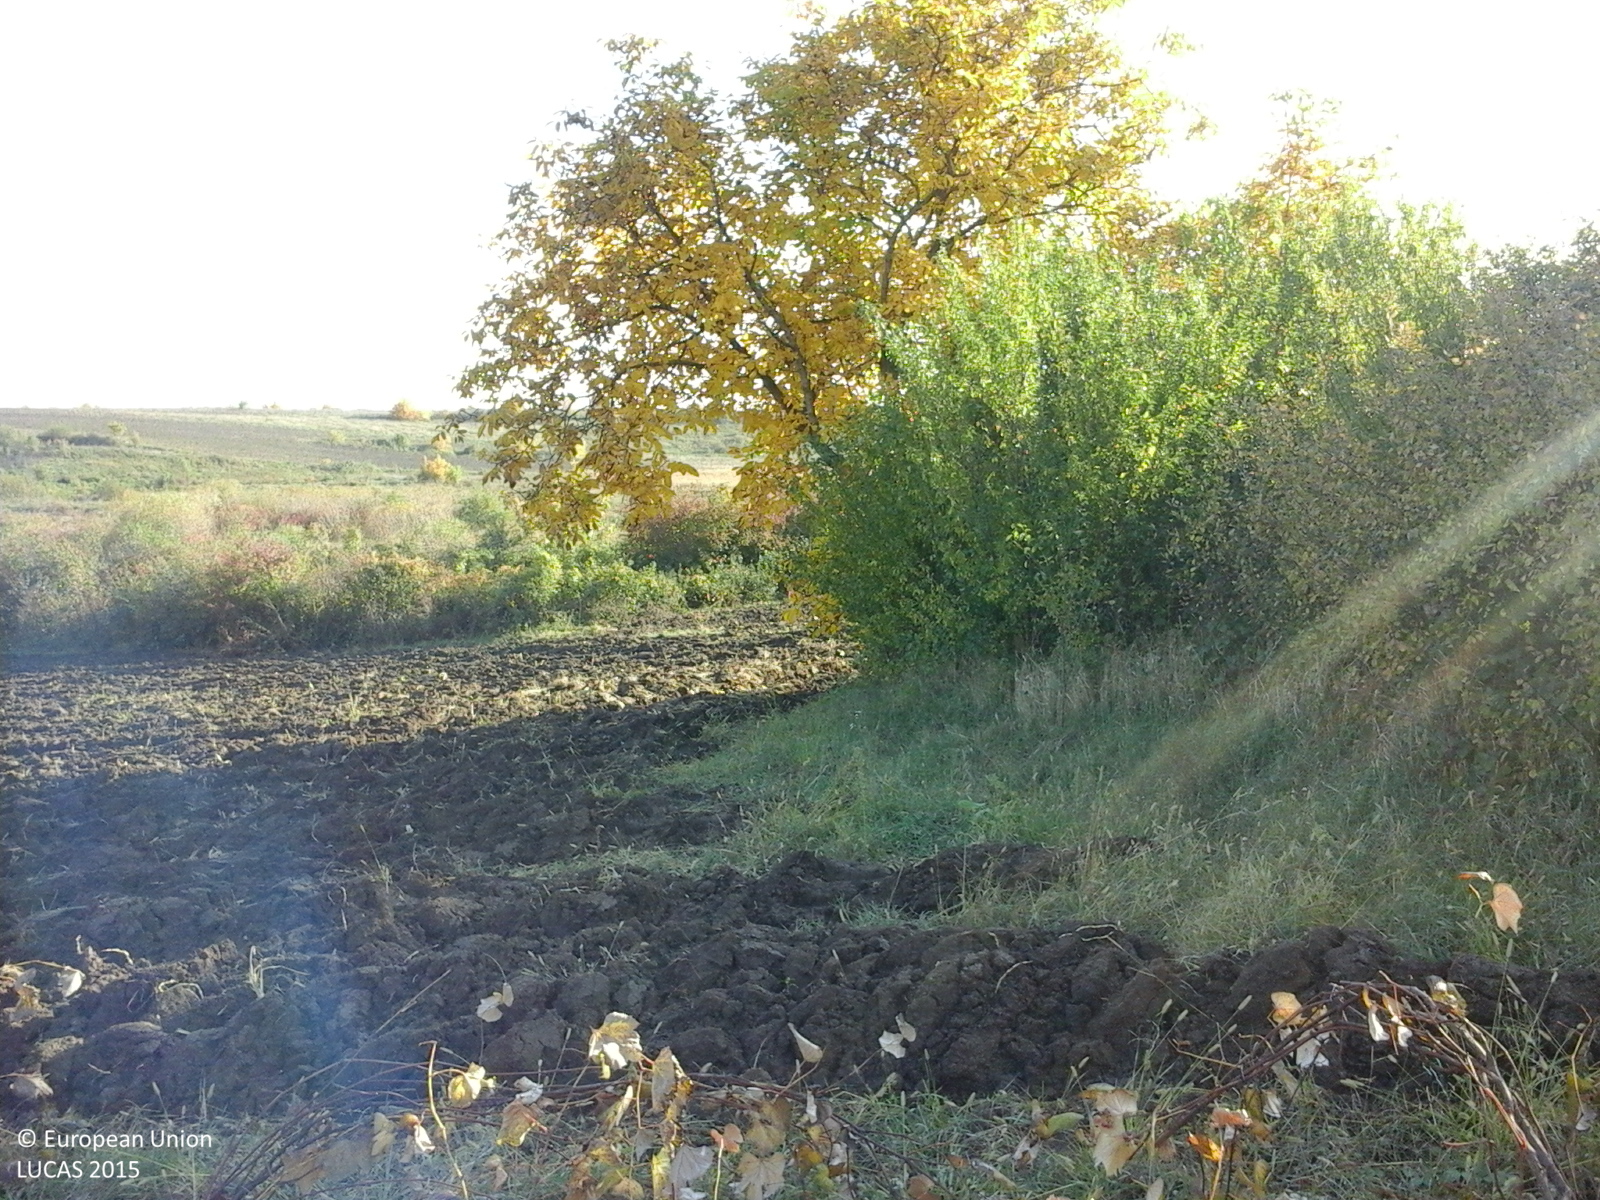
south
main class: Cropland
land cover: Vineyards
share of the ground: > 75 %
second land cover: Grassland without tree/shrub cover
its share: > 75 %
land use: Agriculture (excluding fallow land and kitchen gardens)
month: October
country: RO
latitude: 44.6761
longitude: 26.0129
